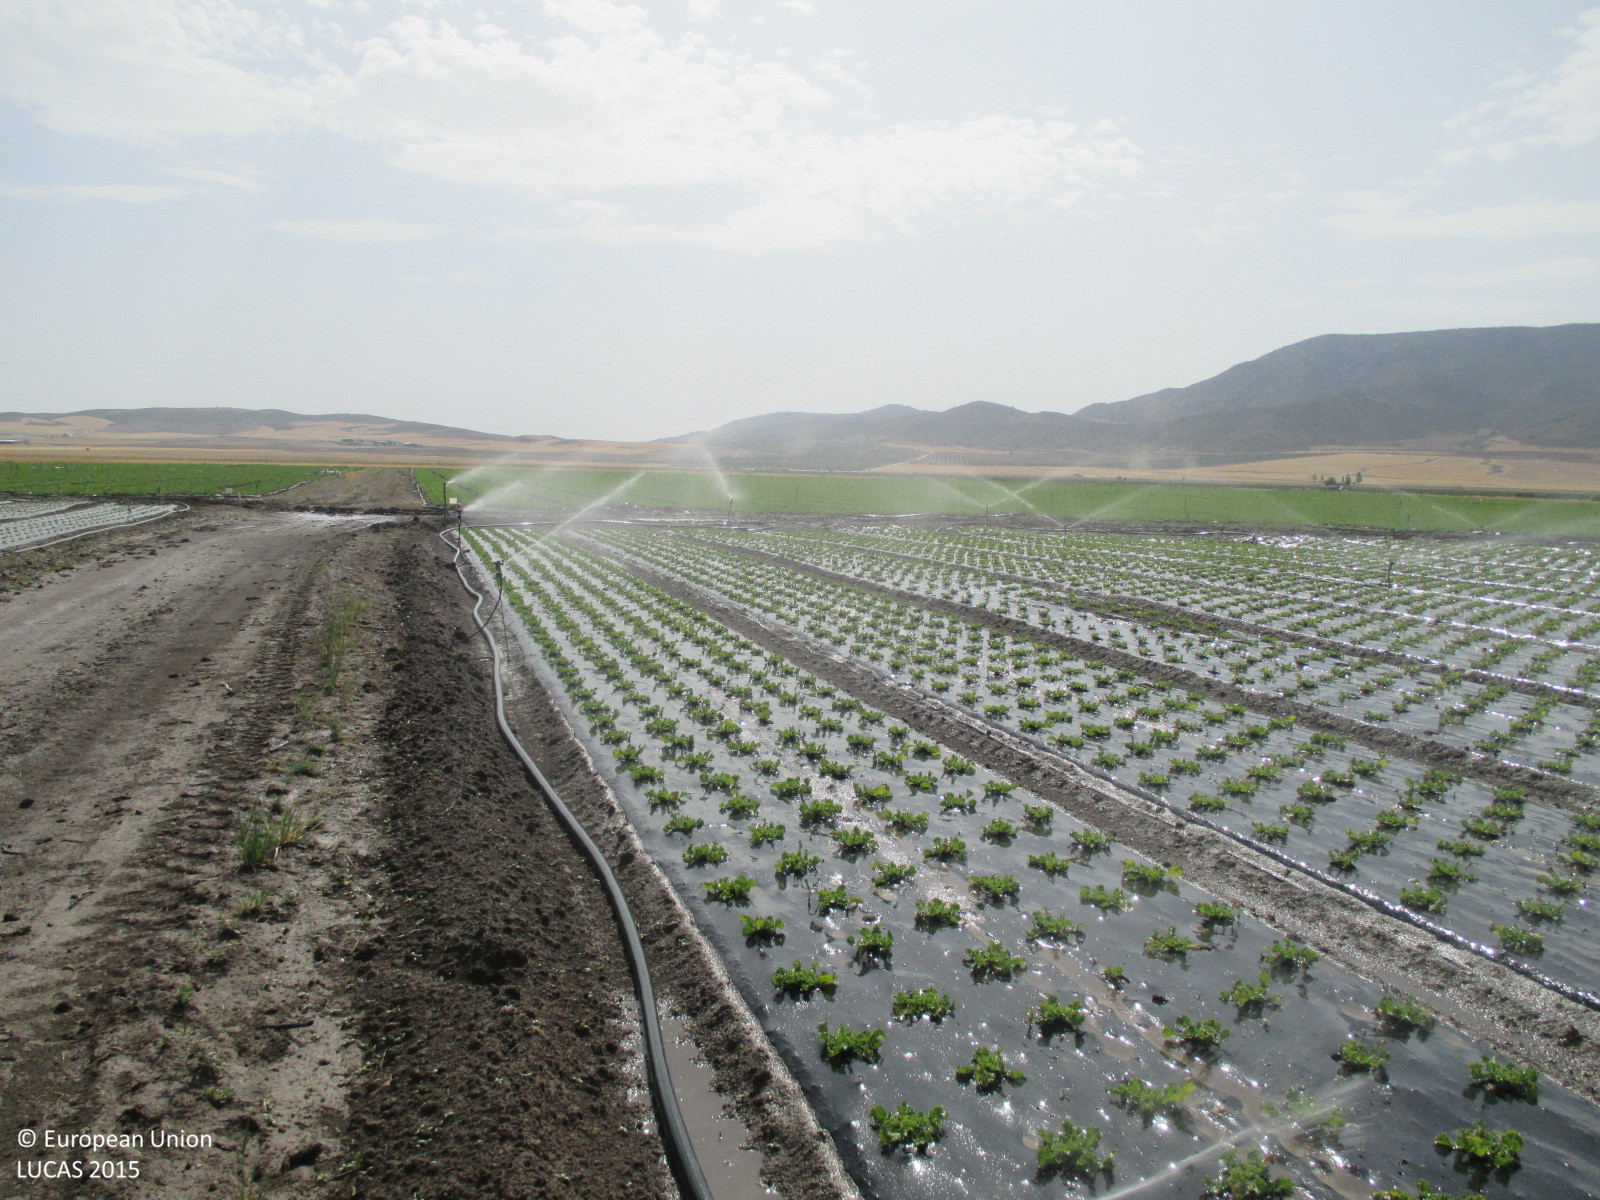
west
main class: Cropland
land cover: Other fresh vegetables
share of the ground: 10 - 25 %
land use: Agriculture (excluding fallow land and kitchen gardens)
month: July
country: ES
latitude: 37.8265
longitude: -2.4298
